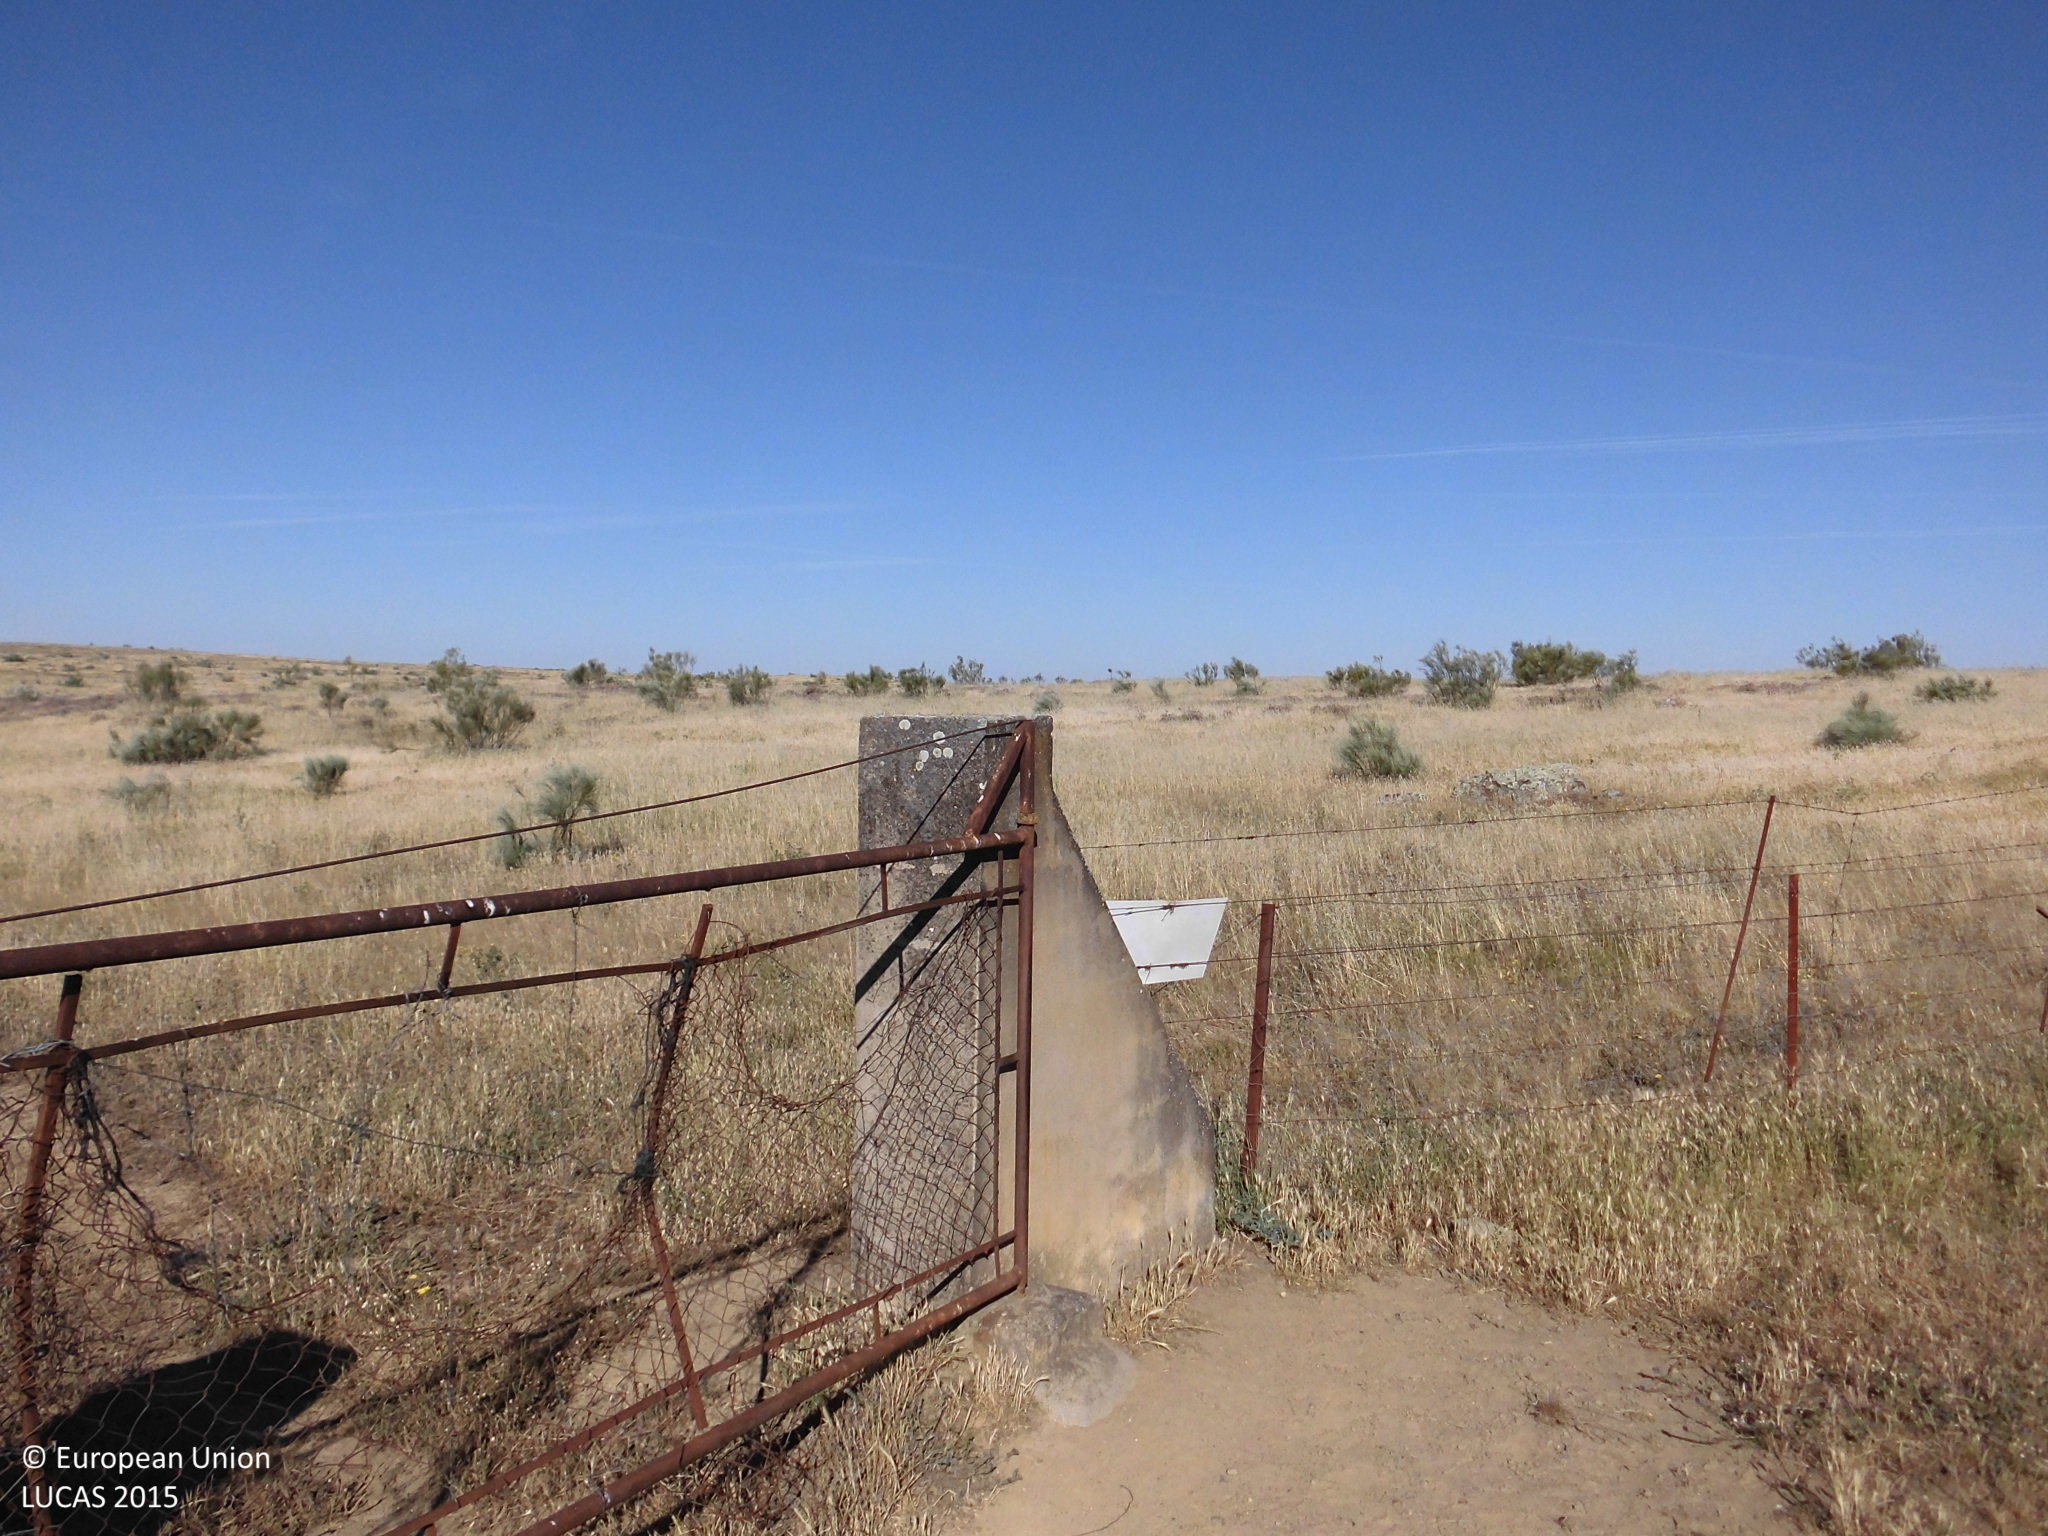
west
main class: Woodland
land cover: Broadleaved woodland
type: broadleaved evergreen forest
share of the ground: 10 - 25 %
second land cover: Grassland without tree/shrub cover
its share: > 75 %
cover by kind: herbaceous plants 85 %, broadleaved forest trees 15 %
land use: Forestry
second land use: Agriculture (excluding fallow land and kitchen gardens)
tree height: > 5 m
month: May
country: ES
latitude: 39.4659
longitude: -6.8265
